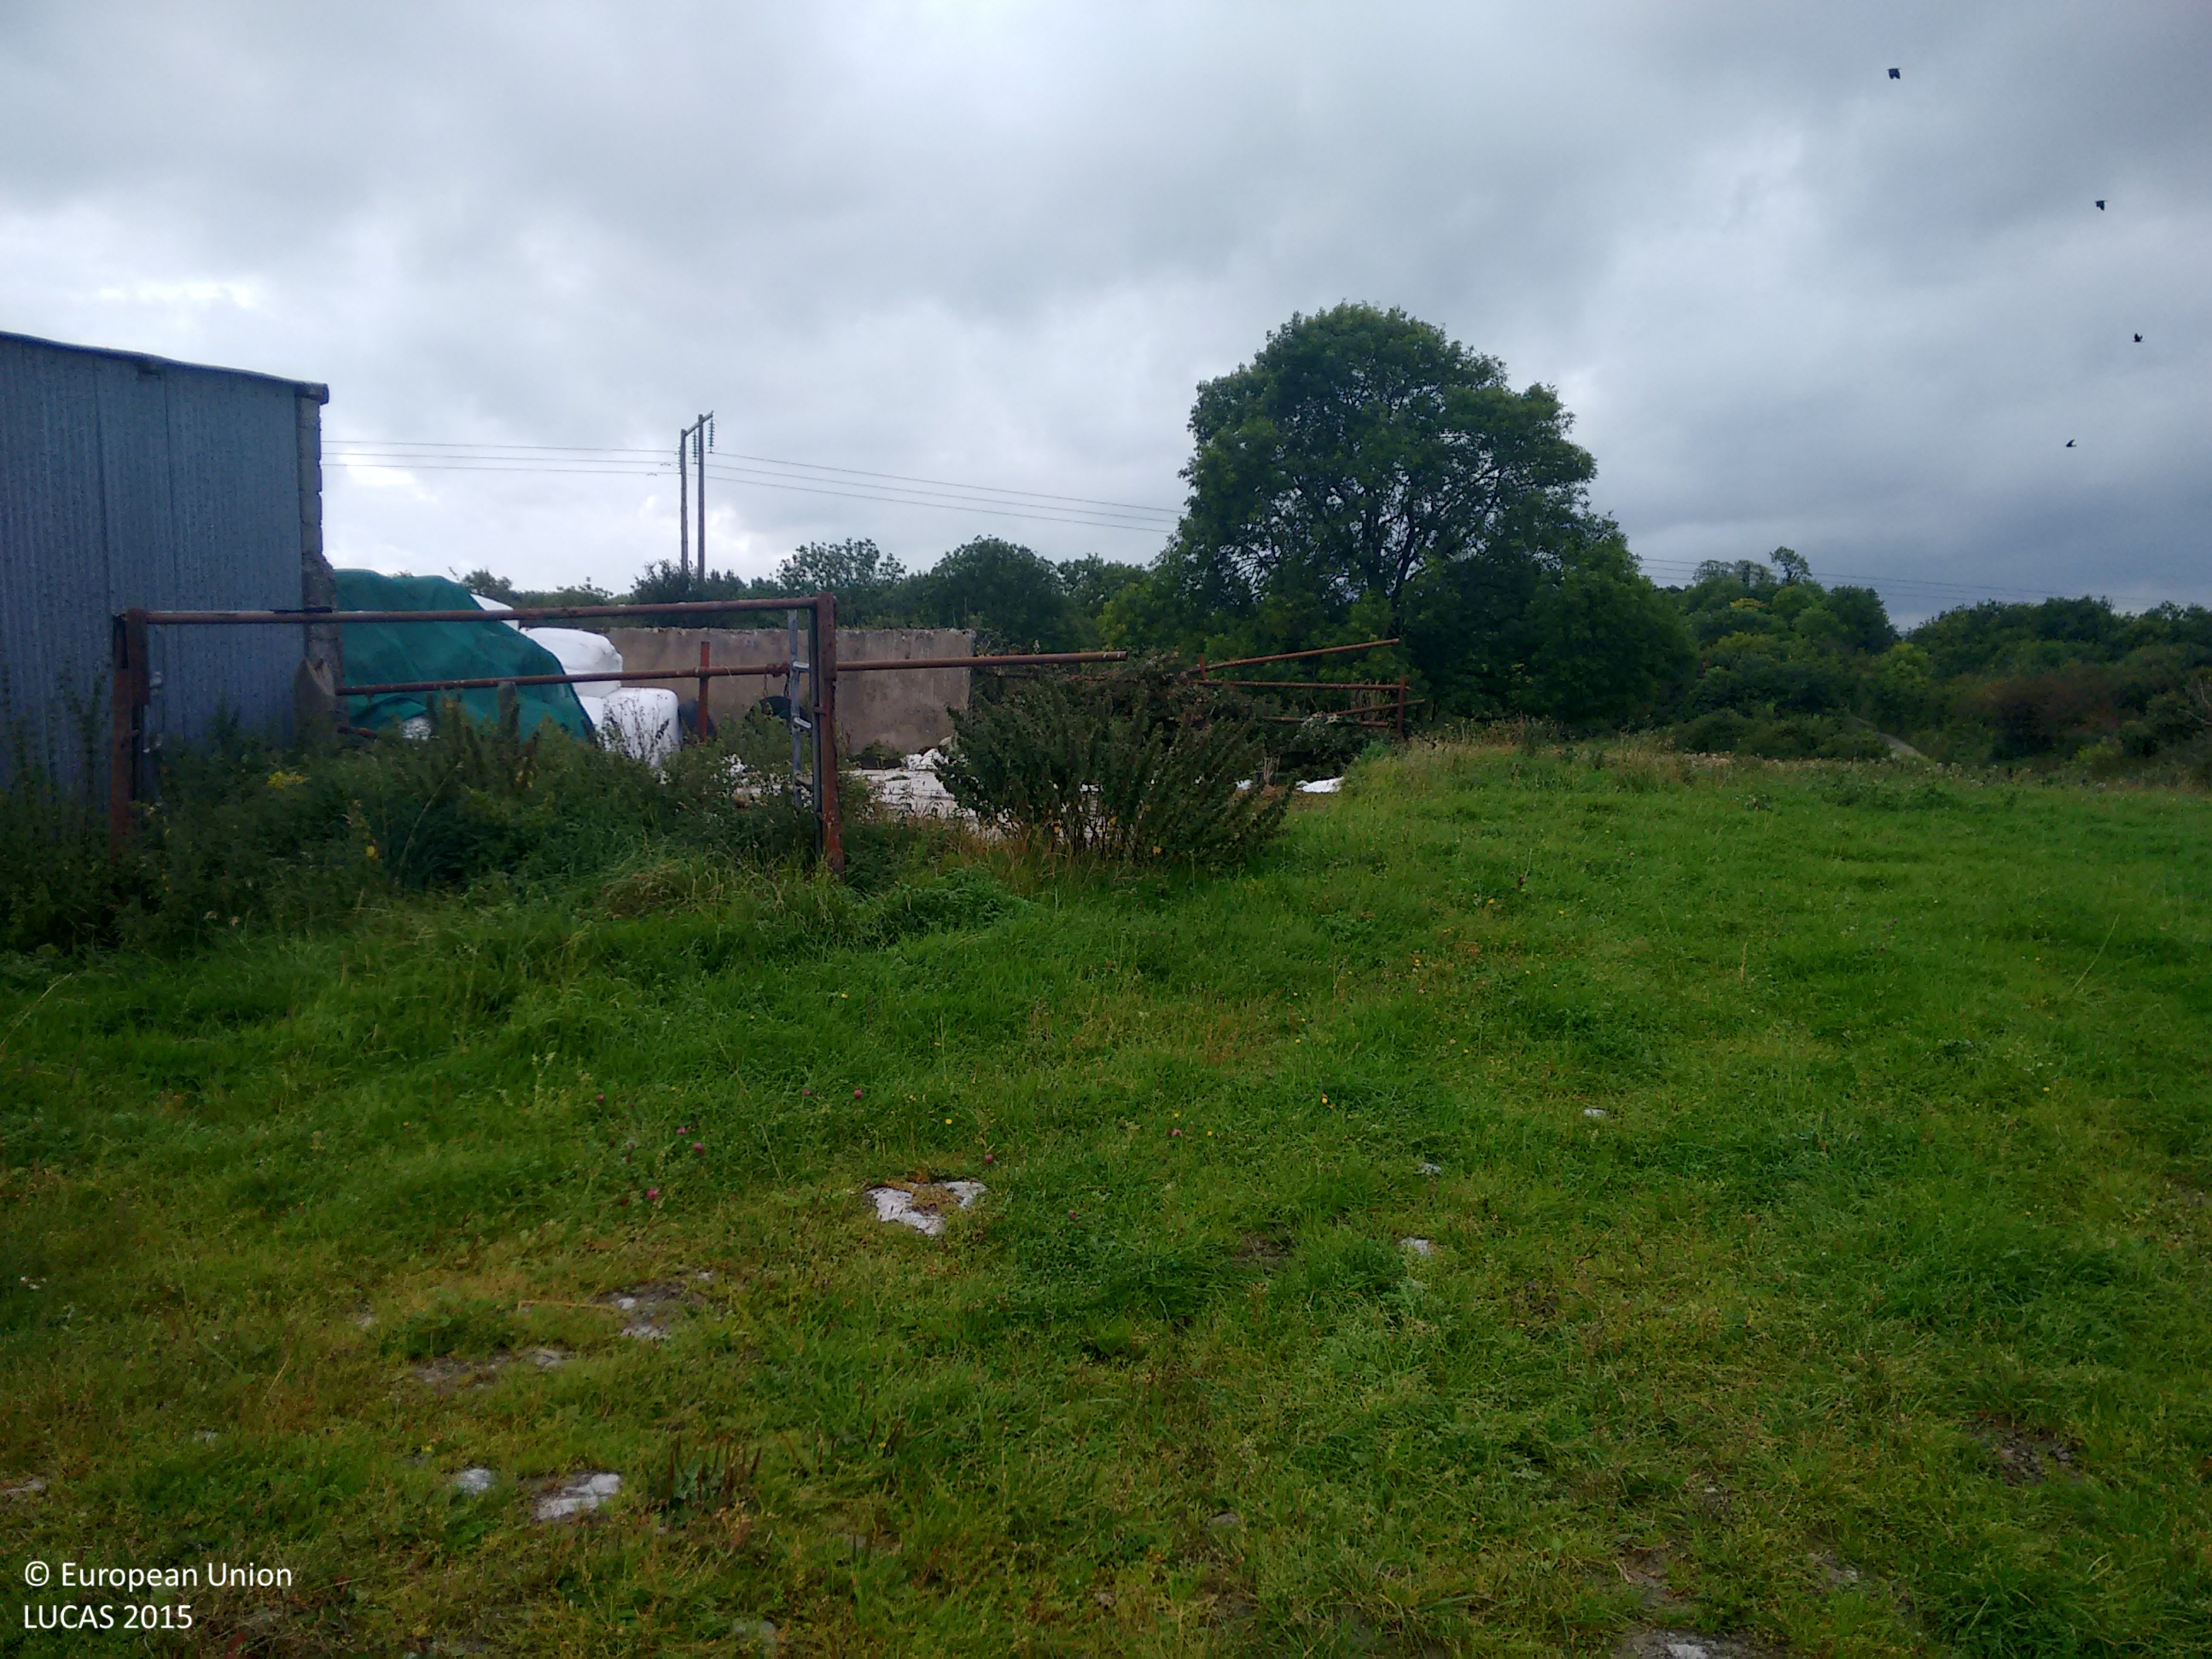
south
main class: Grassland
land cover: Grassland with sparse tree/shrub cover
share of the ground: > 75 %
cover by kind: herbaceous plants 95 %, broadleaved forest trees 5 %
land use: Agriculture (excluding fallow land and kitchen gardens)
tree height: > 5 m
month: September
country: IE
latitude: 52.5703
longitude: -9.0566
